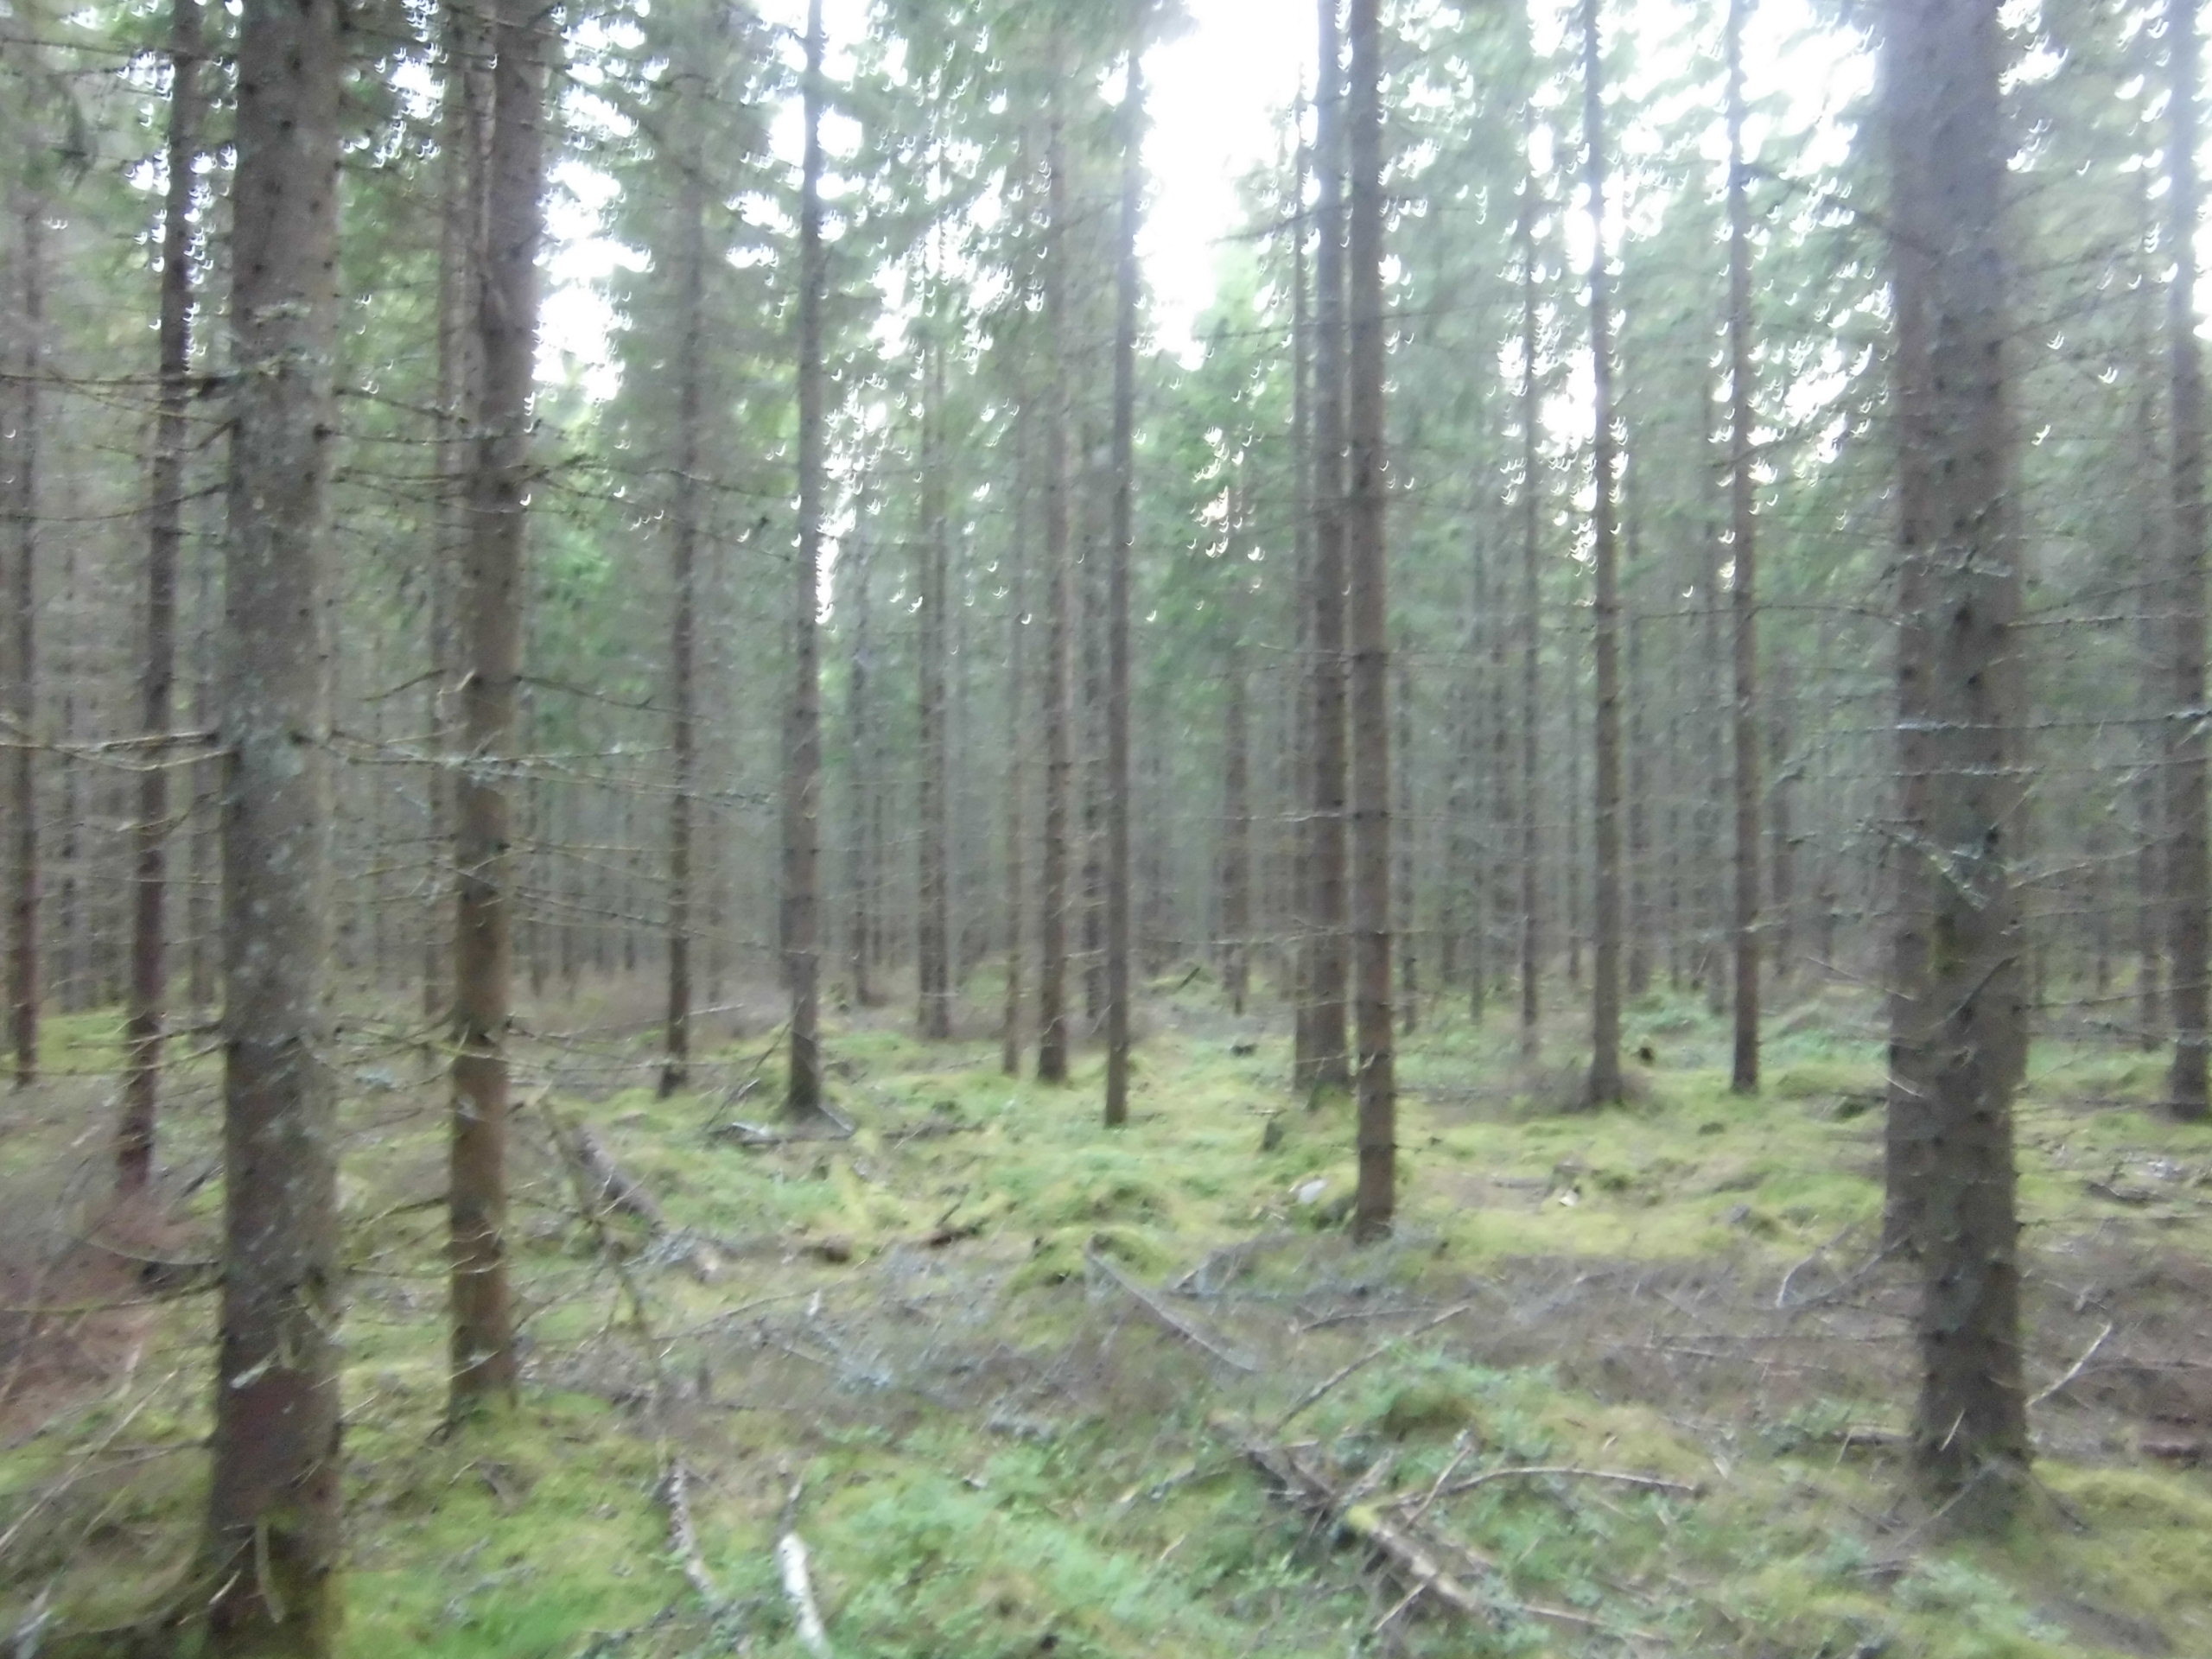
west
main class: Woodland
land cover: Spruce dominated coniferous woodland
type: boreal forest
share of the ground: 50 - 75 %
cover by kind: coniferous forest trees 65 %, shrubs 15 %, lichens and mosses 15 %, herbaceous plants 5 %
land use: Forestry
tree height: > 5 m
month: July
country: SE
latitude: 57.4475
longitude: 14.8450
